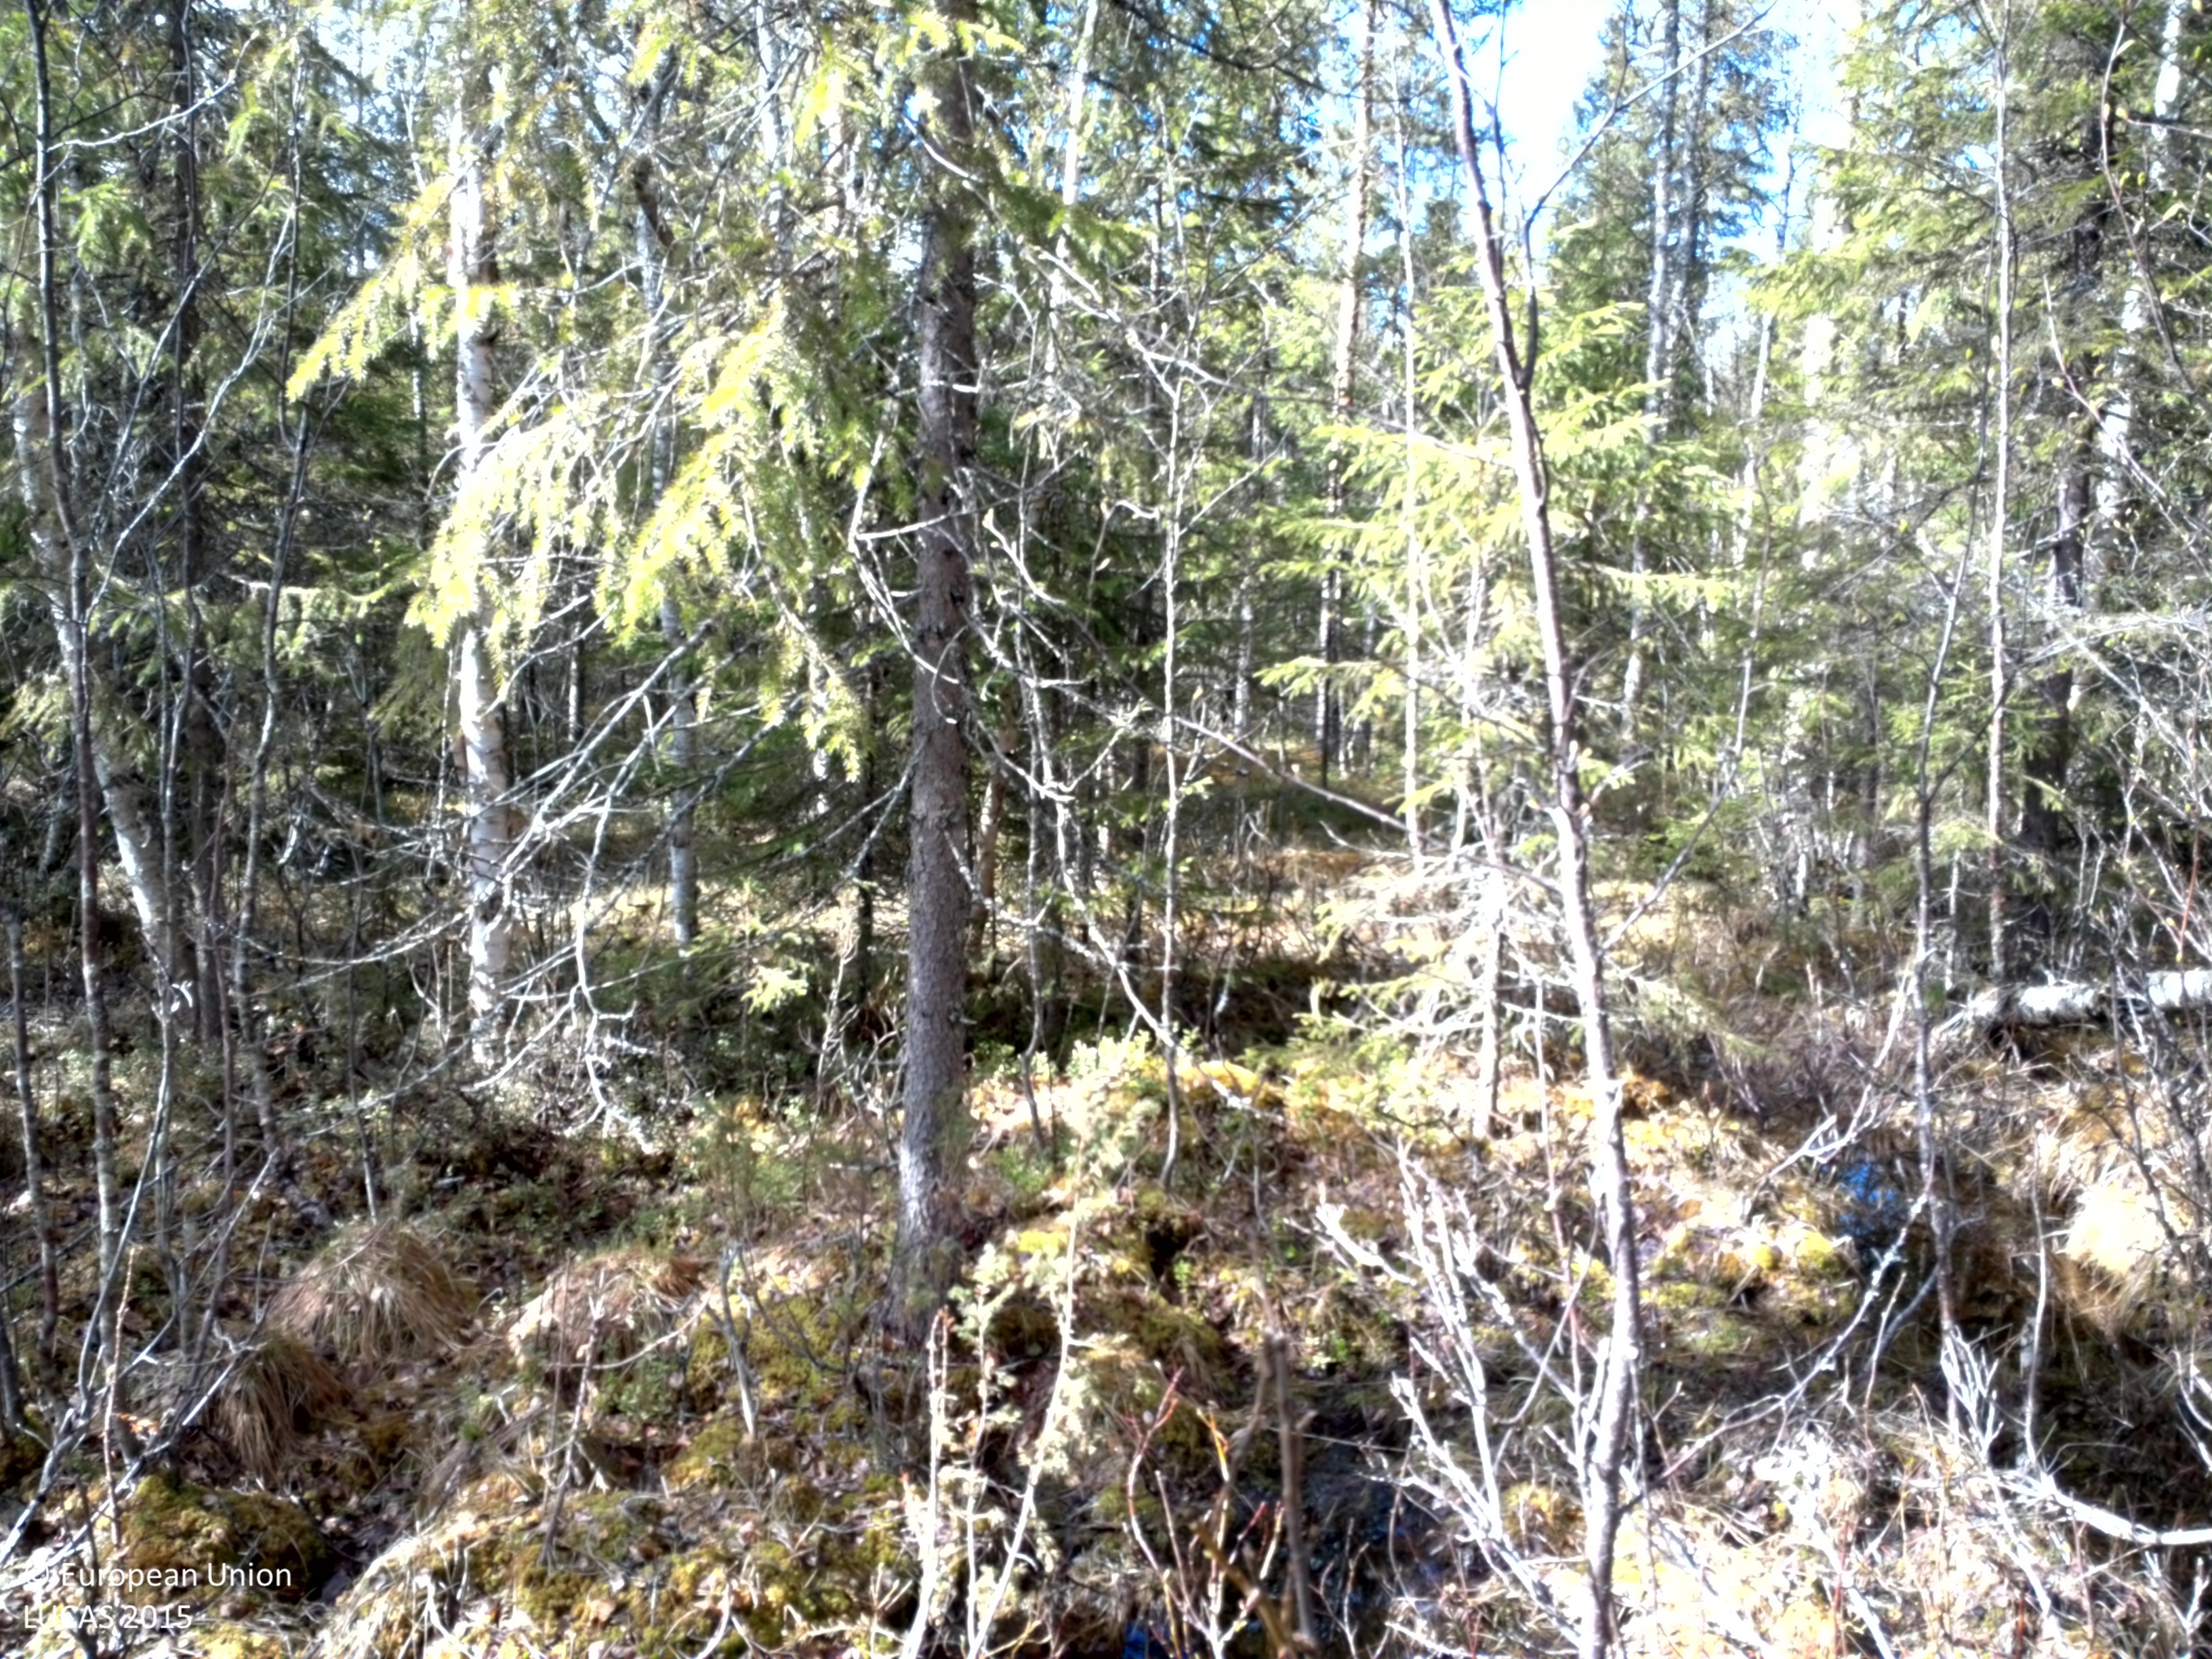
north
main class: Woodland
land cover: Spruce dominated mixed woodland
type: boreal forest
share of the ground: > 75 %
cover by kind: coniferous forest trees 65 %, broadleaved forest trees 25 %, shrubs 10 %
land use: Forestry
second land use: Amenities, museums, leisure
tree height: > 5 m
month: June
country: SE
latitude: 63.6071
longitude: 14.6347
